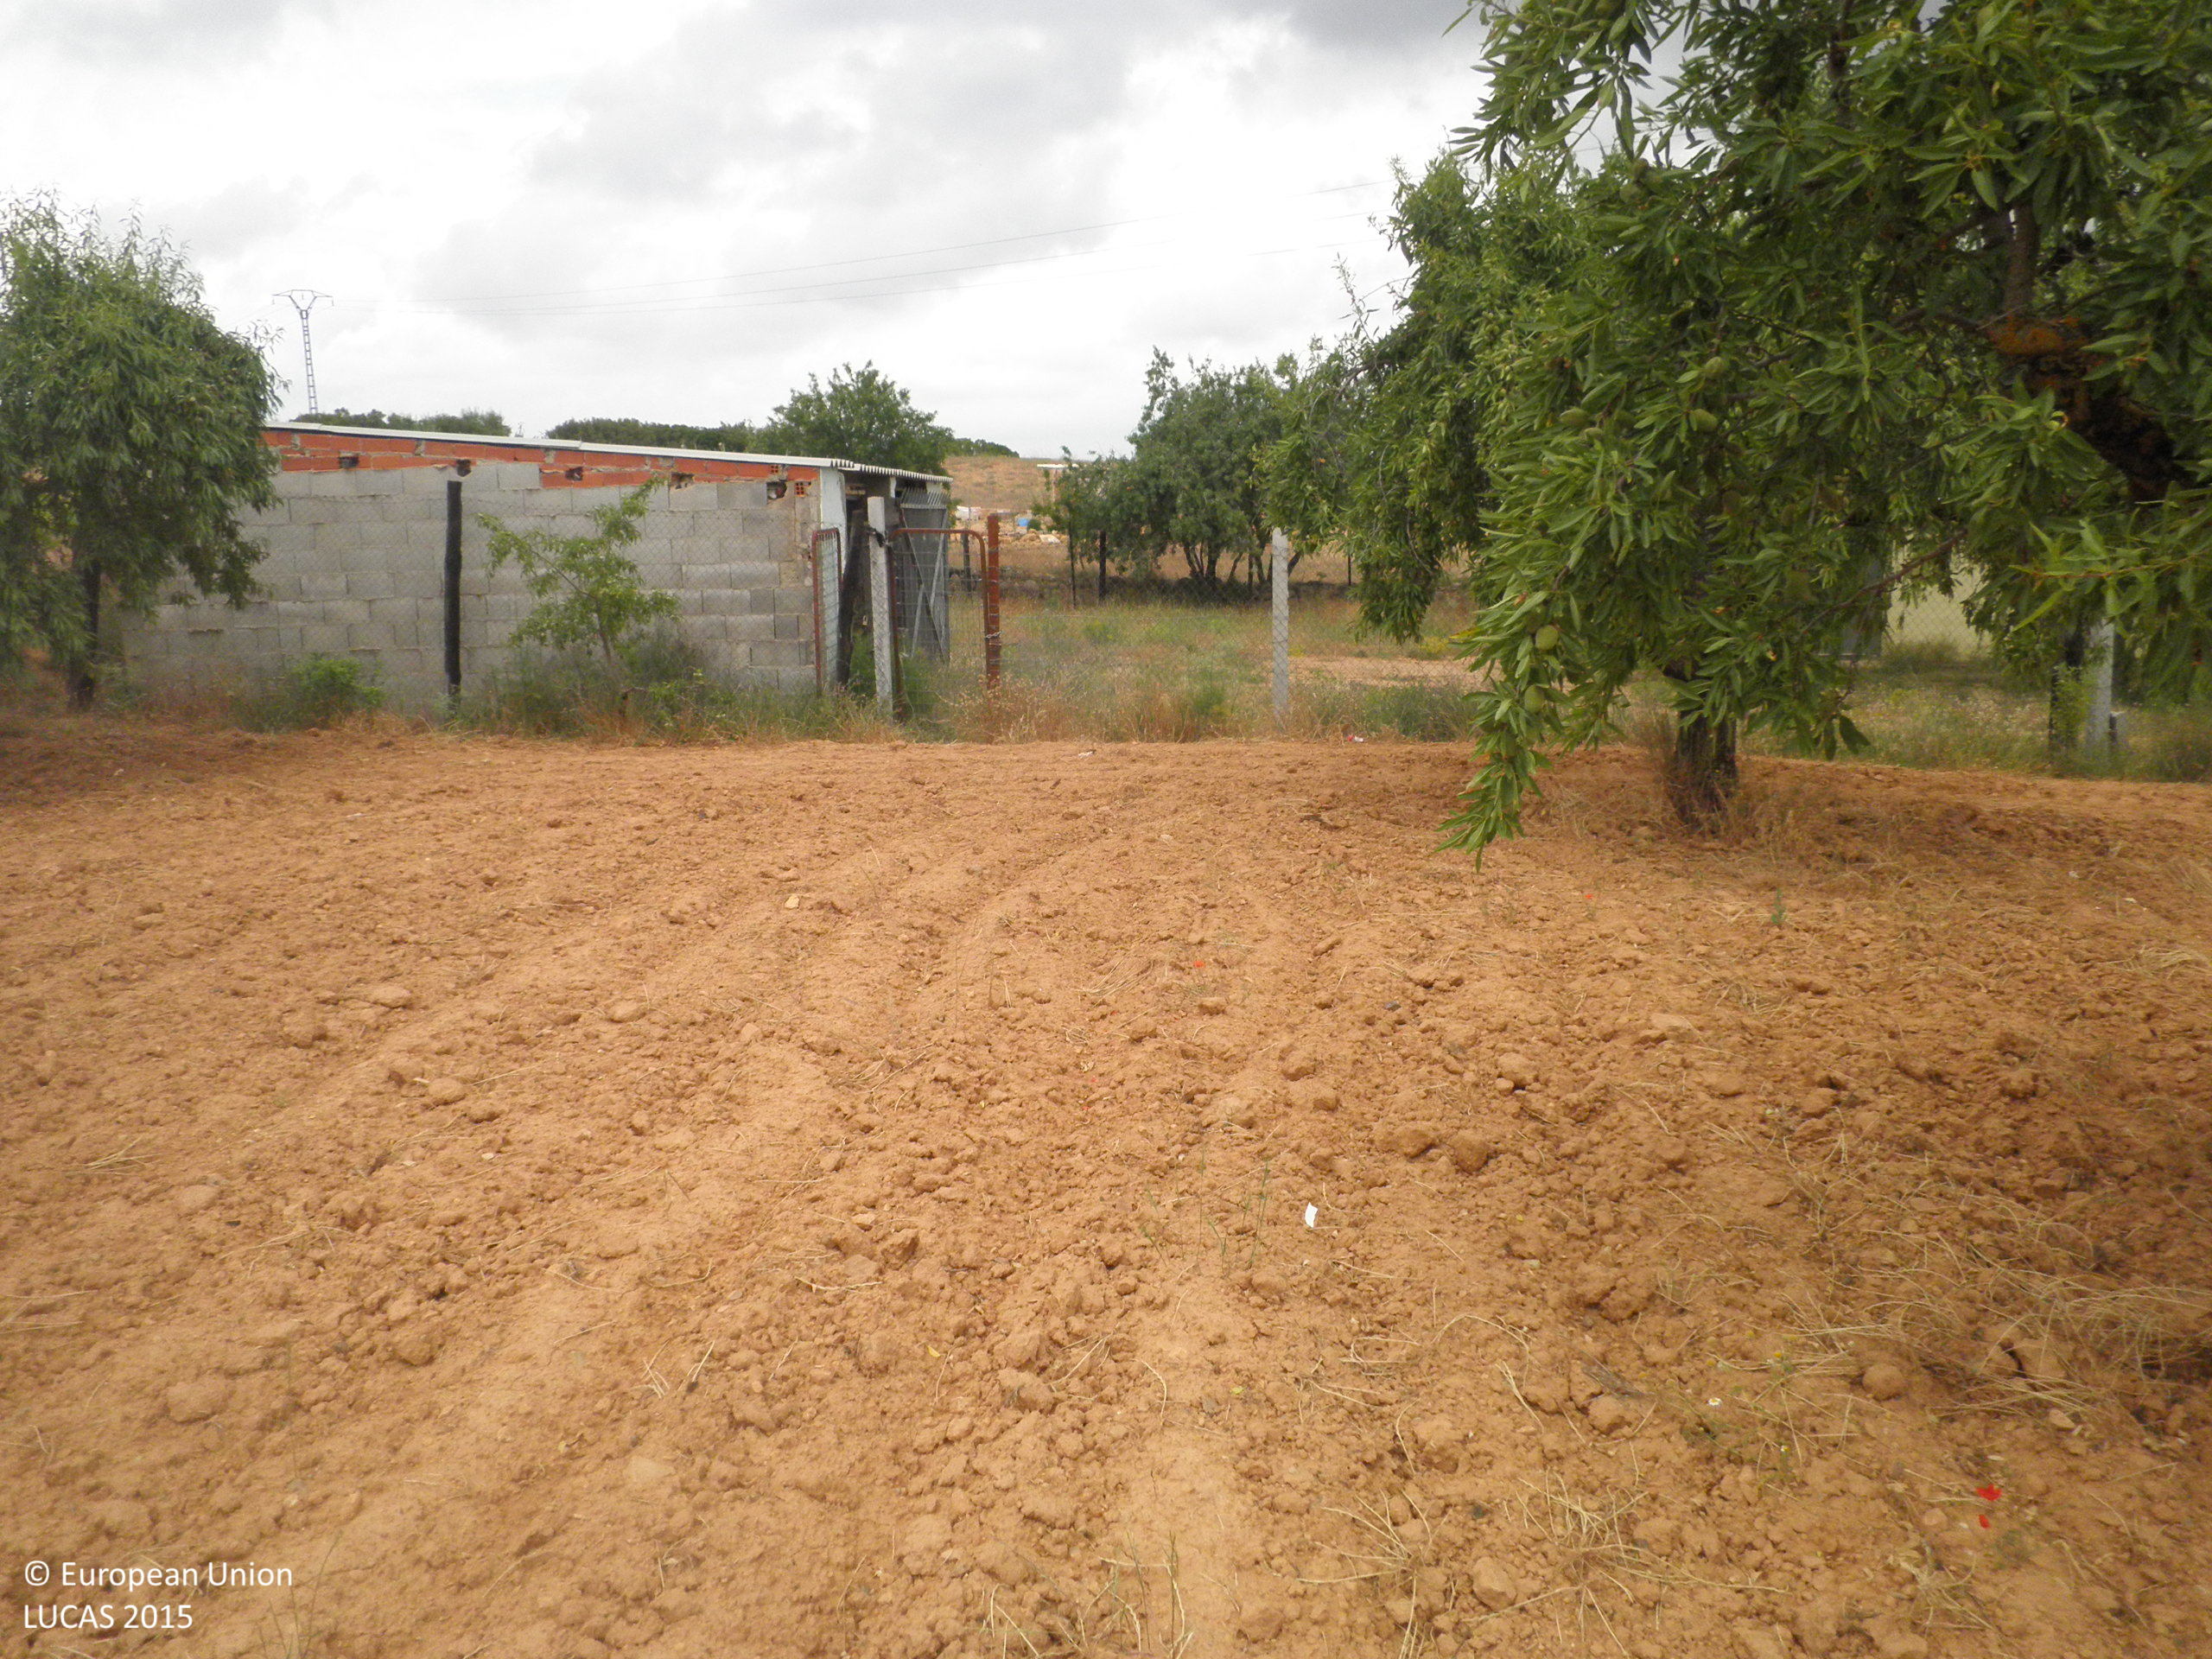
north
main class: Cropland
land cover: Nuts trees
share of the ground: < 10 %
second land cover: Other bare soil
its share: > 75 %
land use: Agriculture (excluding fallow land and kitchen gardens)
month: June
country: ES
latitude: 39.5395
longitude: -1.6059
